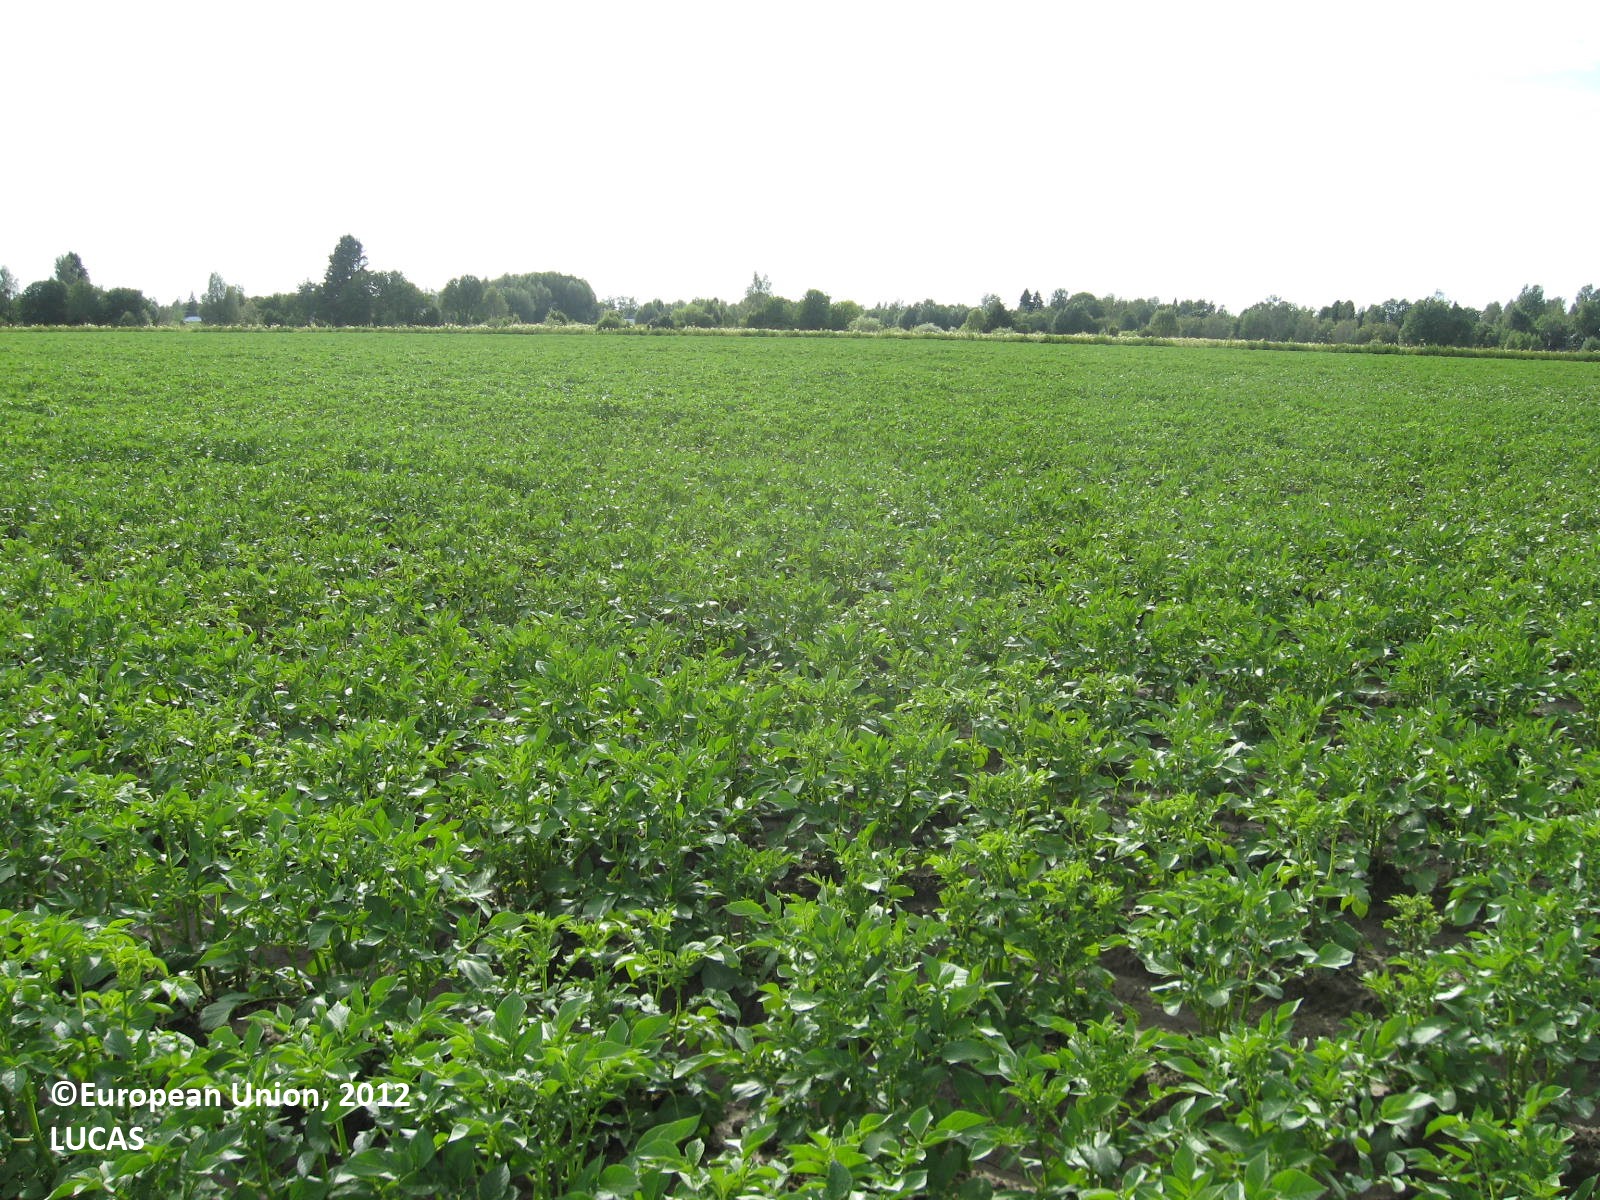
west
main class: Cropland
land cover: Potatoes
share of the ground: 50 - 75 %
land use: Agriculture (excluding fallow land and kitchen gardens)
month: July
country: FI
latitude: 62.2583
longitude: 21.5420
